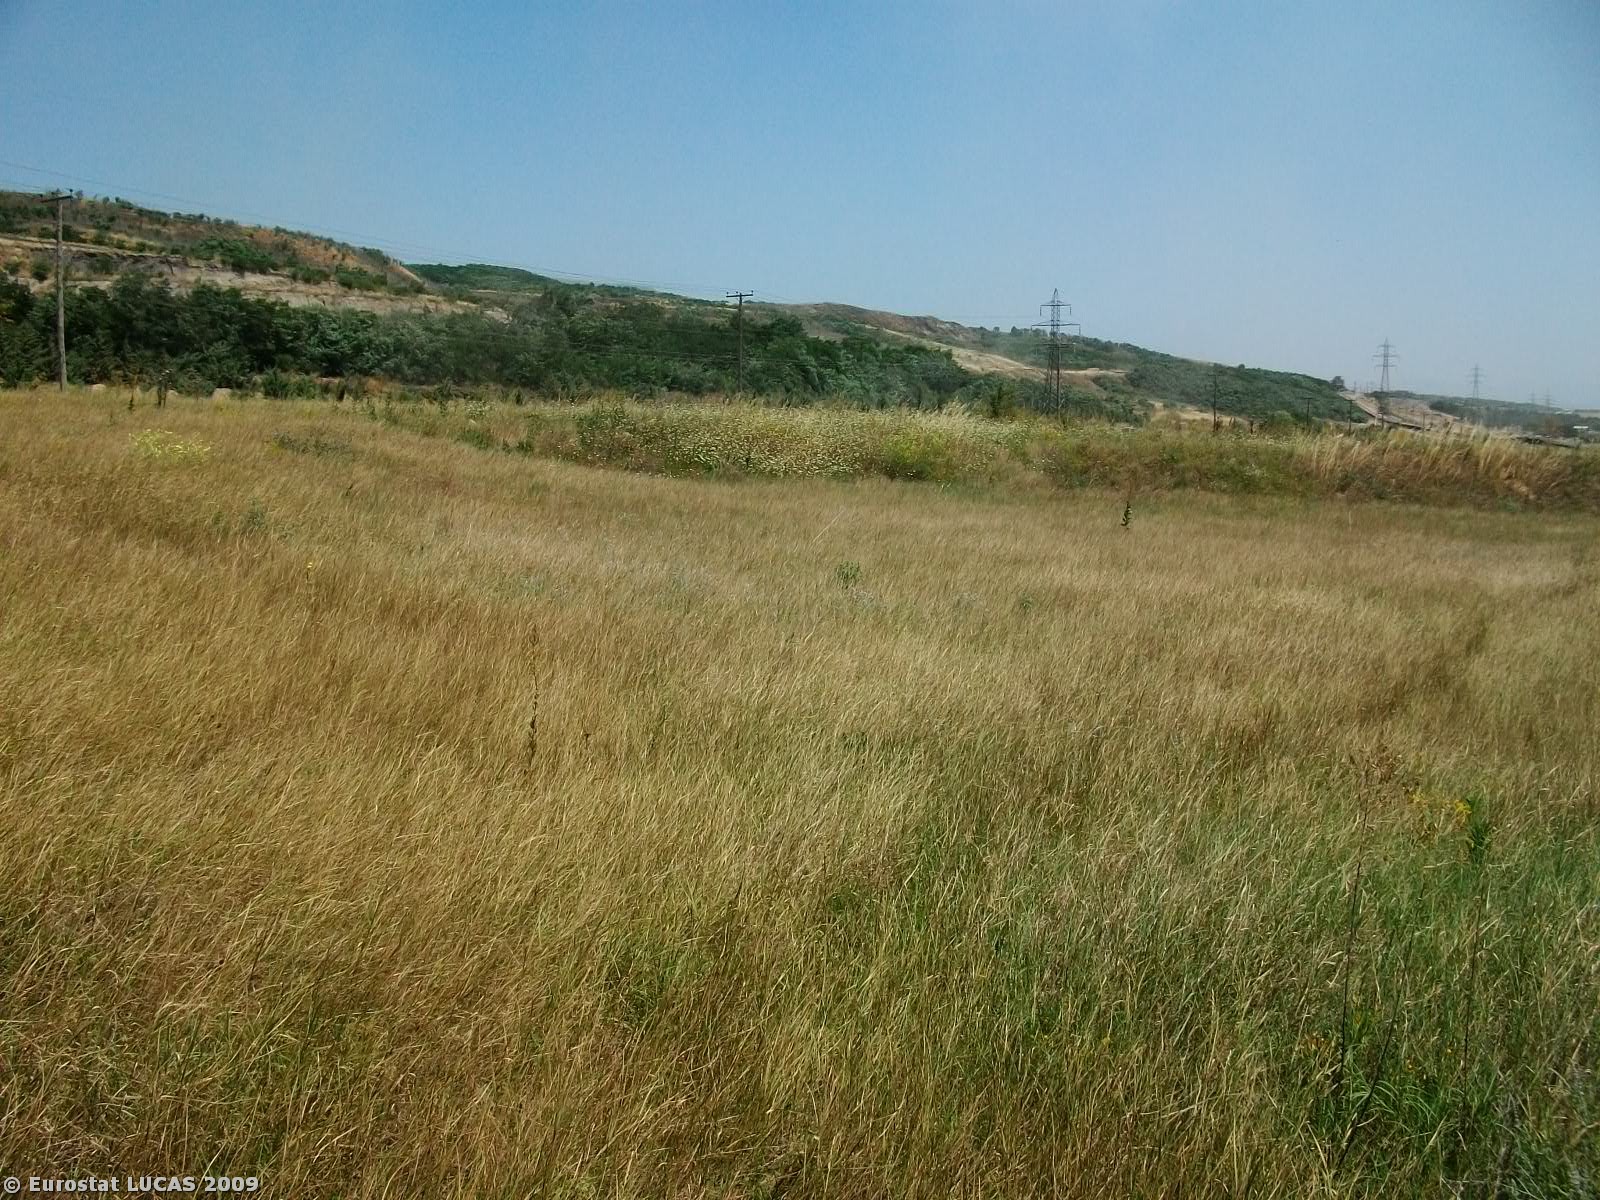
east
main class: Grassland
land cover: Grassland without tree/shrub cover
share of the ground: > 75 %
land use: Unused
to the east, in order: Grassland without tree/shrub cover; Electric lines; Grassland without tree/shrub cover; Fences; Abandoned hedges; Paved roads, cycling and walking lanes; Abandoned hedges; Grass margins; Paved roads, cycling and walking lanes; Electric lines; Grassland without tree/shrub cover; Broadleaved woodland; Electric lines; Broadleaved woodland
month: July
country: GR
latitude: 40.4629
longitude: 21.8226
